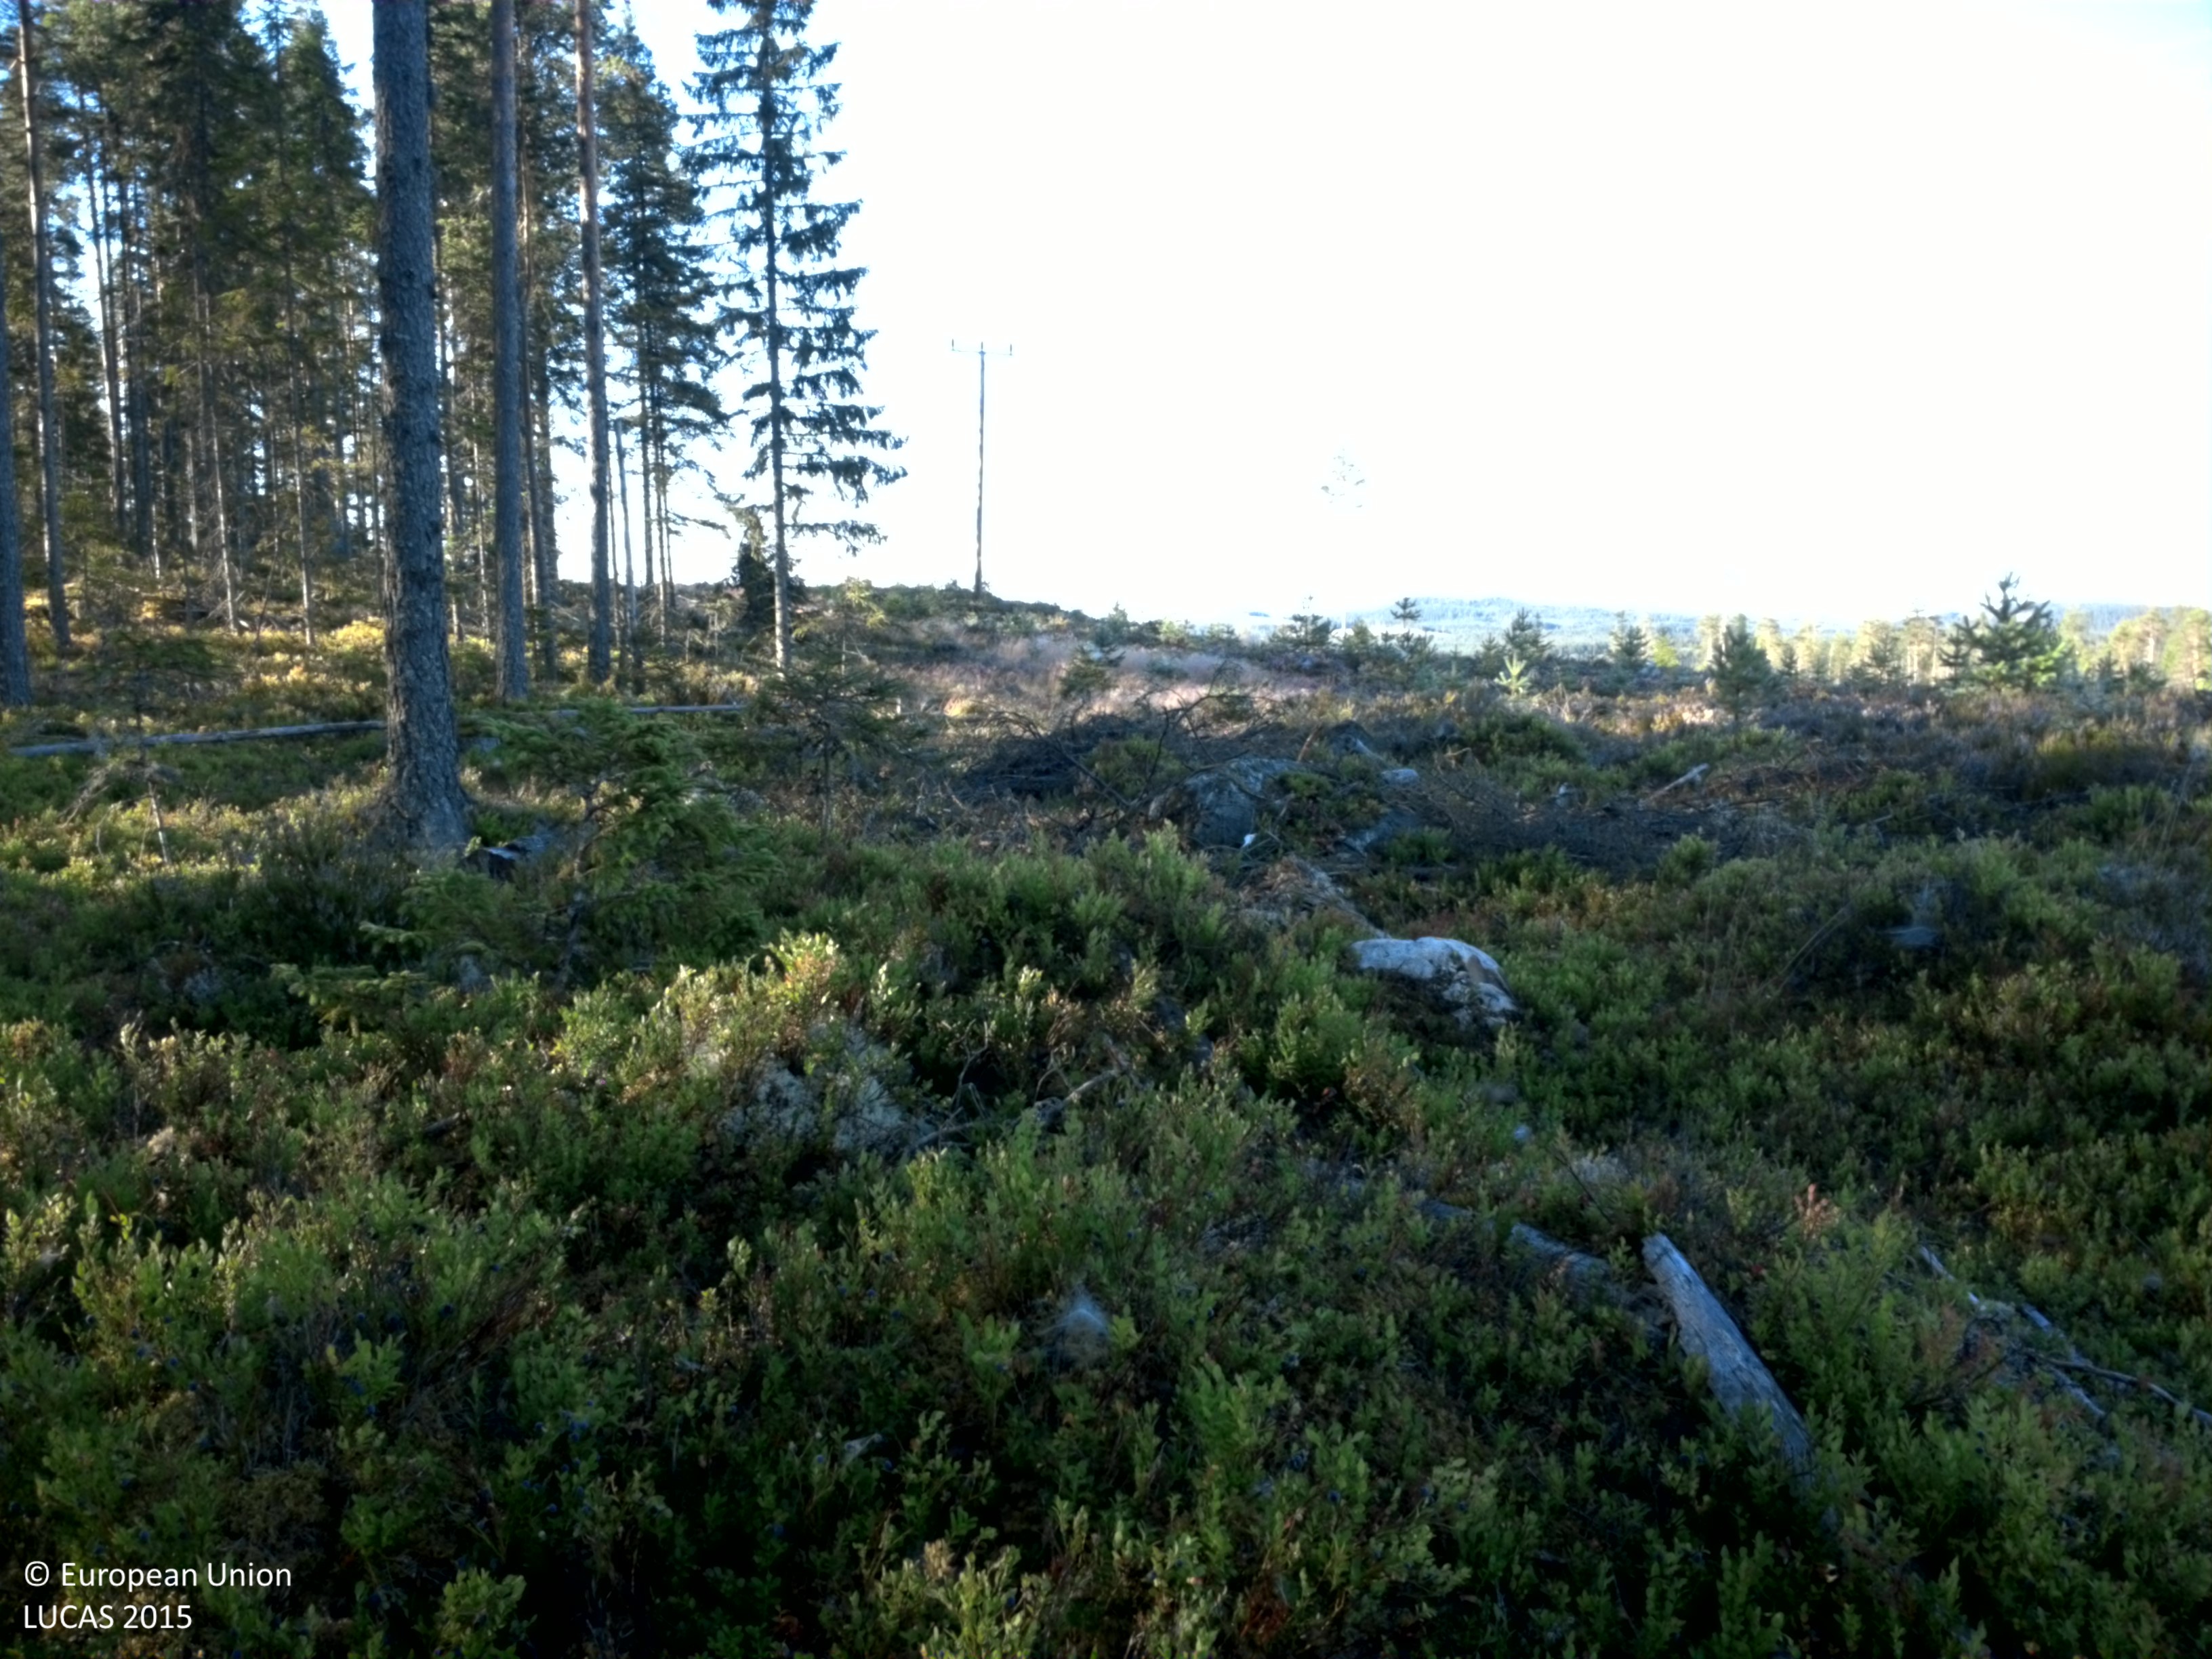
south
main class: Woodland
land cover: Other coniferous woodland
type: boreal forest
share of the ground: 50 - 75 %
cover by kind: coniferous forest trees 70 %, shrubs 30 %
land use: Forestry
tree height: > 5 m
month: August
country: SE
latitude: 60.0109
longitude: 14.1690
